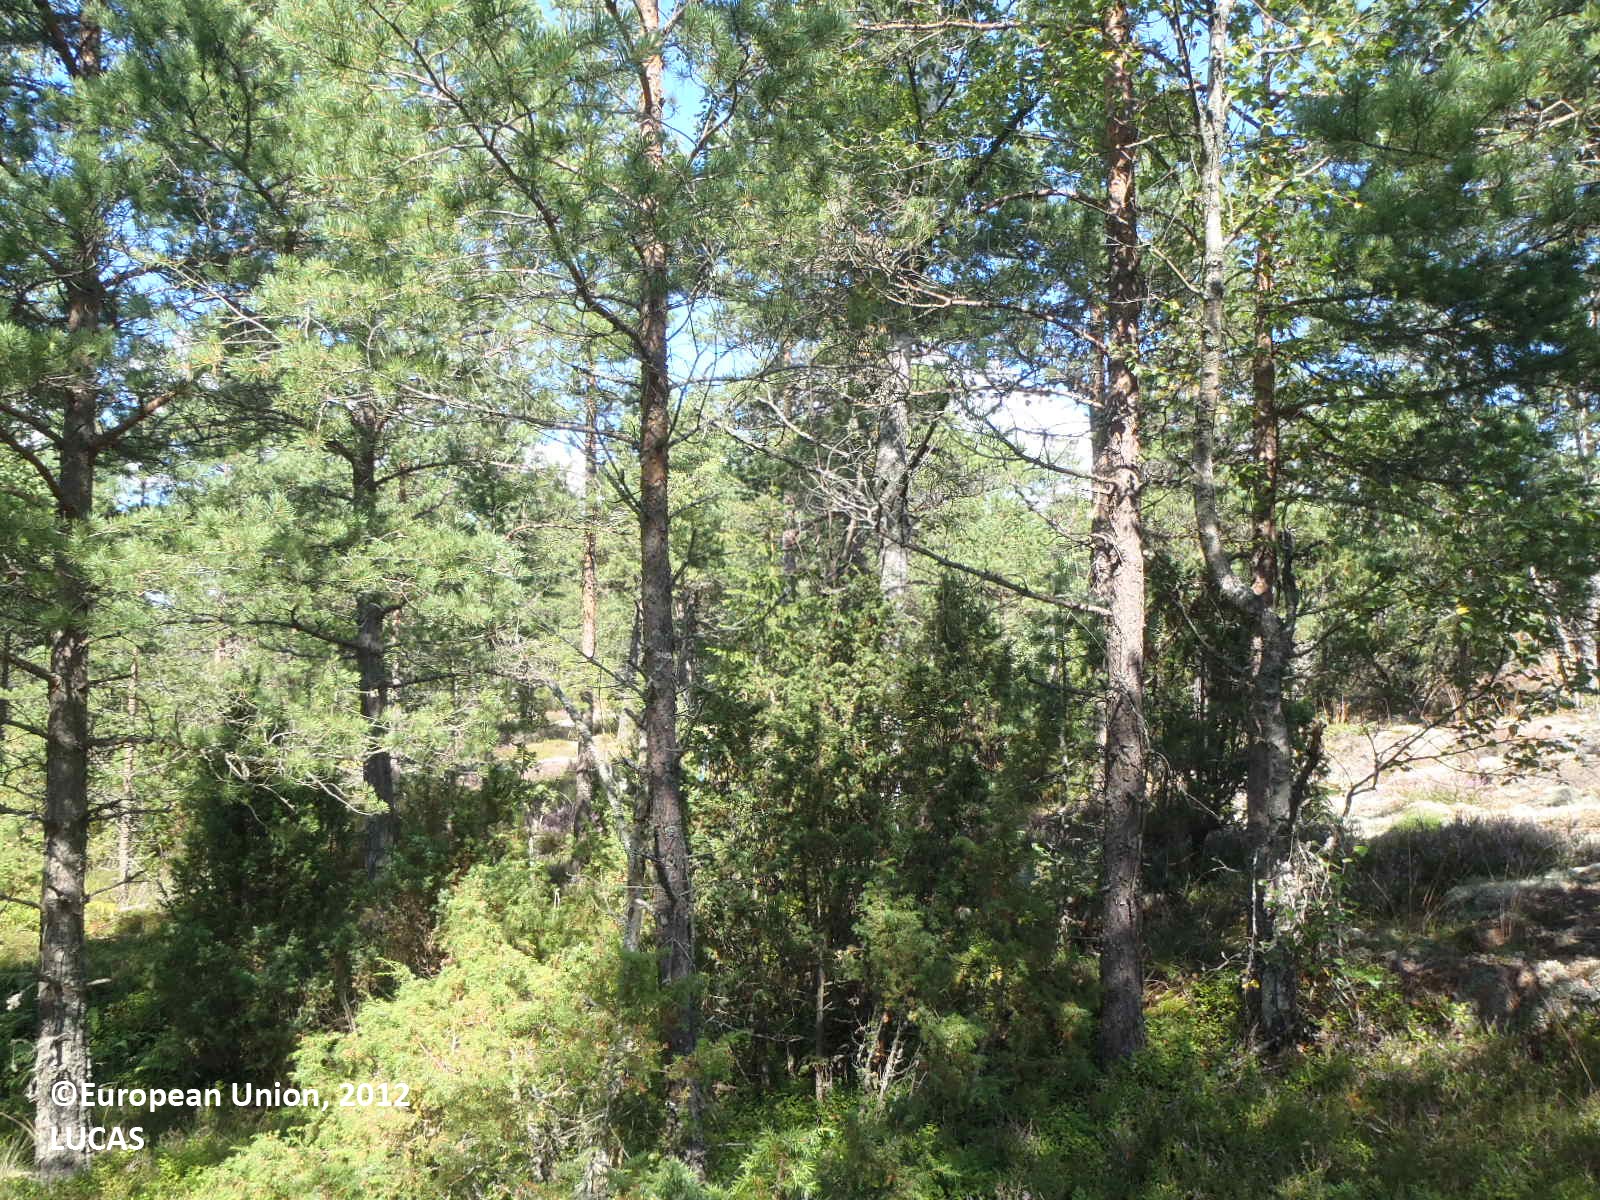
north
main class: Woodland
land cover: Pine dominated coniferous woodland
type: hemiboreal forest and nemoral coniferous forest and mixed broadleaved-coniferous forest
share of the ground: > 75 %
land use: Forestry
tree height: > 5 m
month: August
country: FI
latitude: 60.1741
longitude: 19.9382
